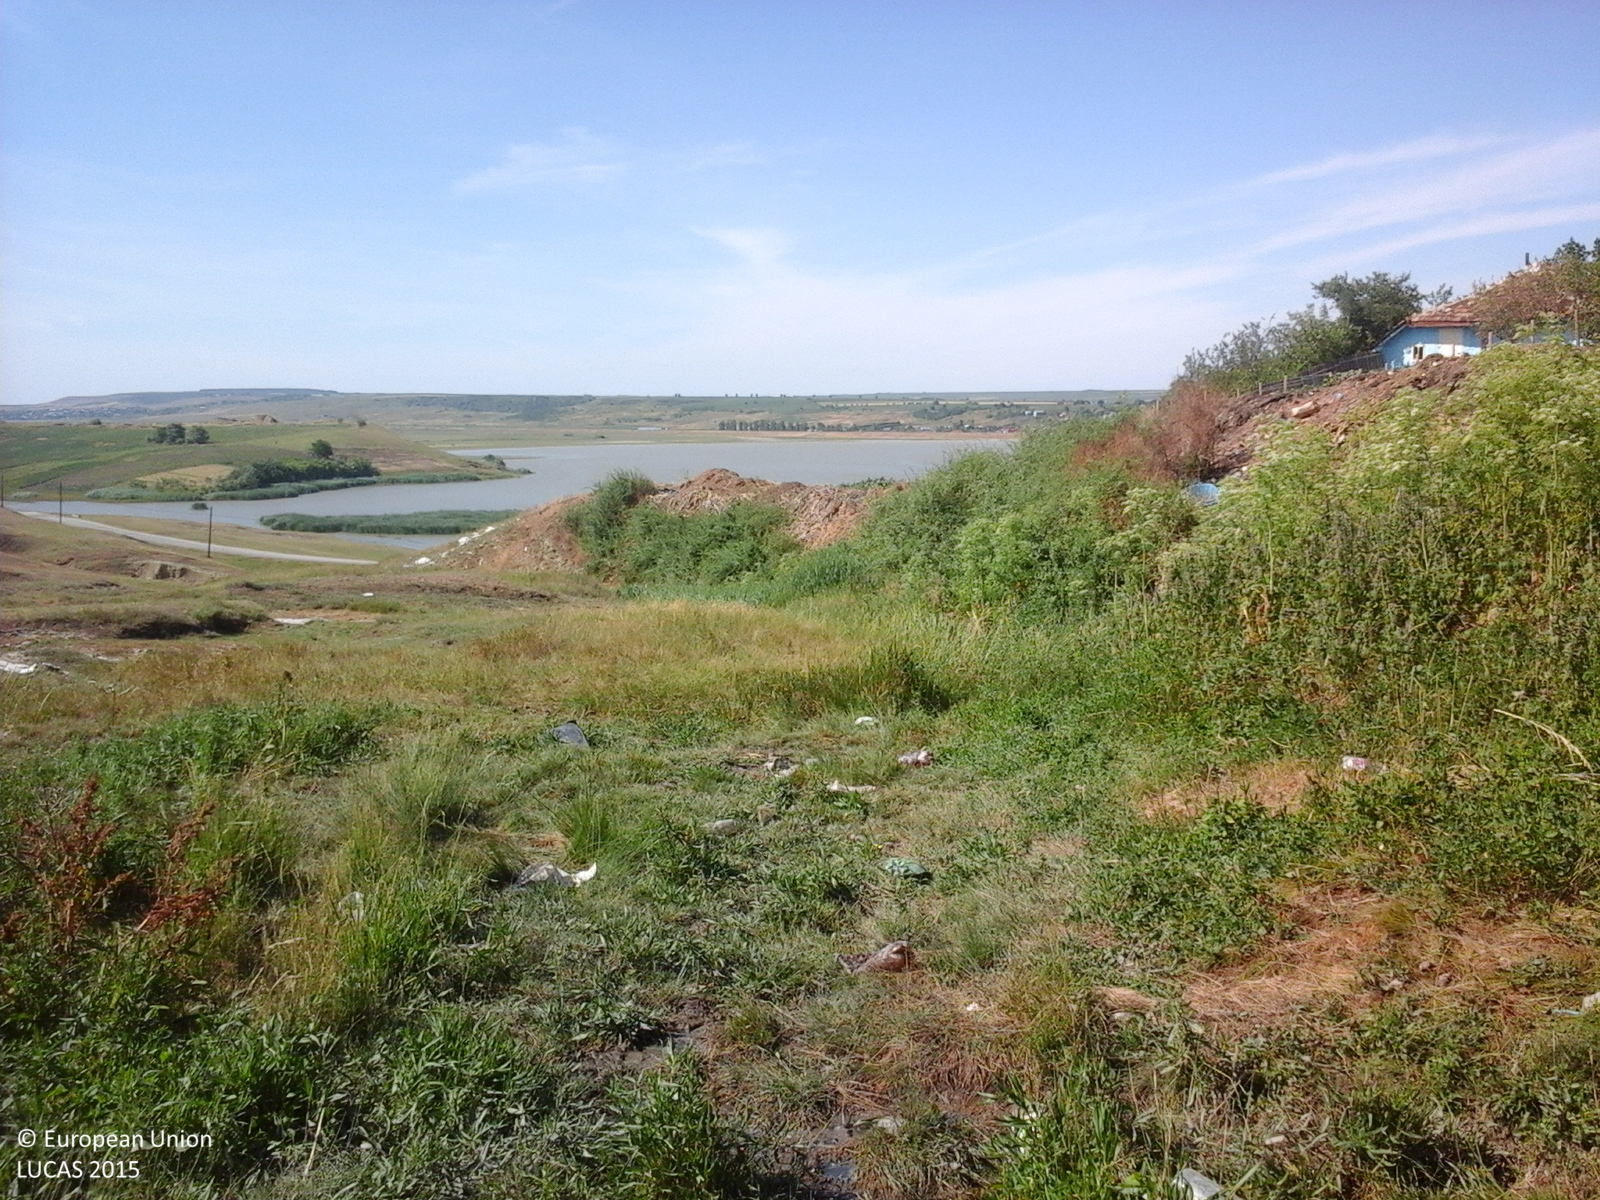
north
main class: Grassland
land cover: Spontaneously vegetated surfaces
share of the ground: > 75 %
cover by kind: herbaceous plants 100 %
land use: Agriculture (excluding fallow land and kitchen gardens)
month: June
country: RO
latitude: 47.2841
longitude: 27.0664
